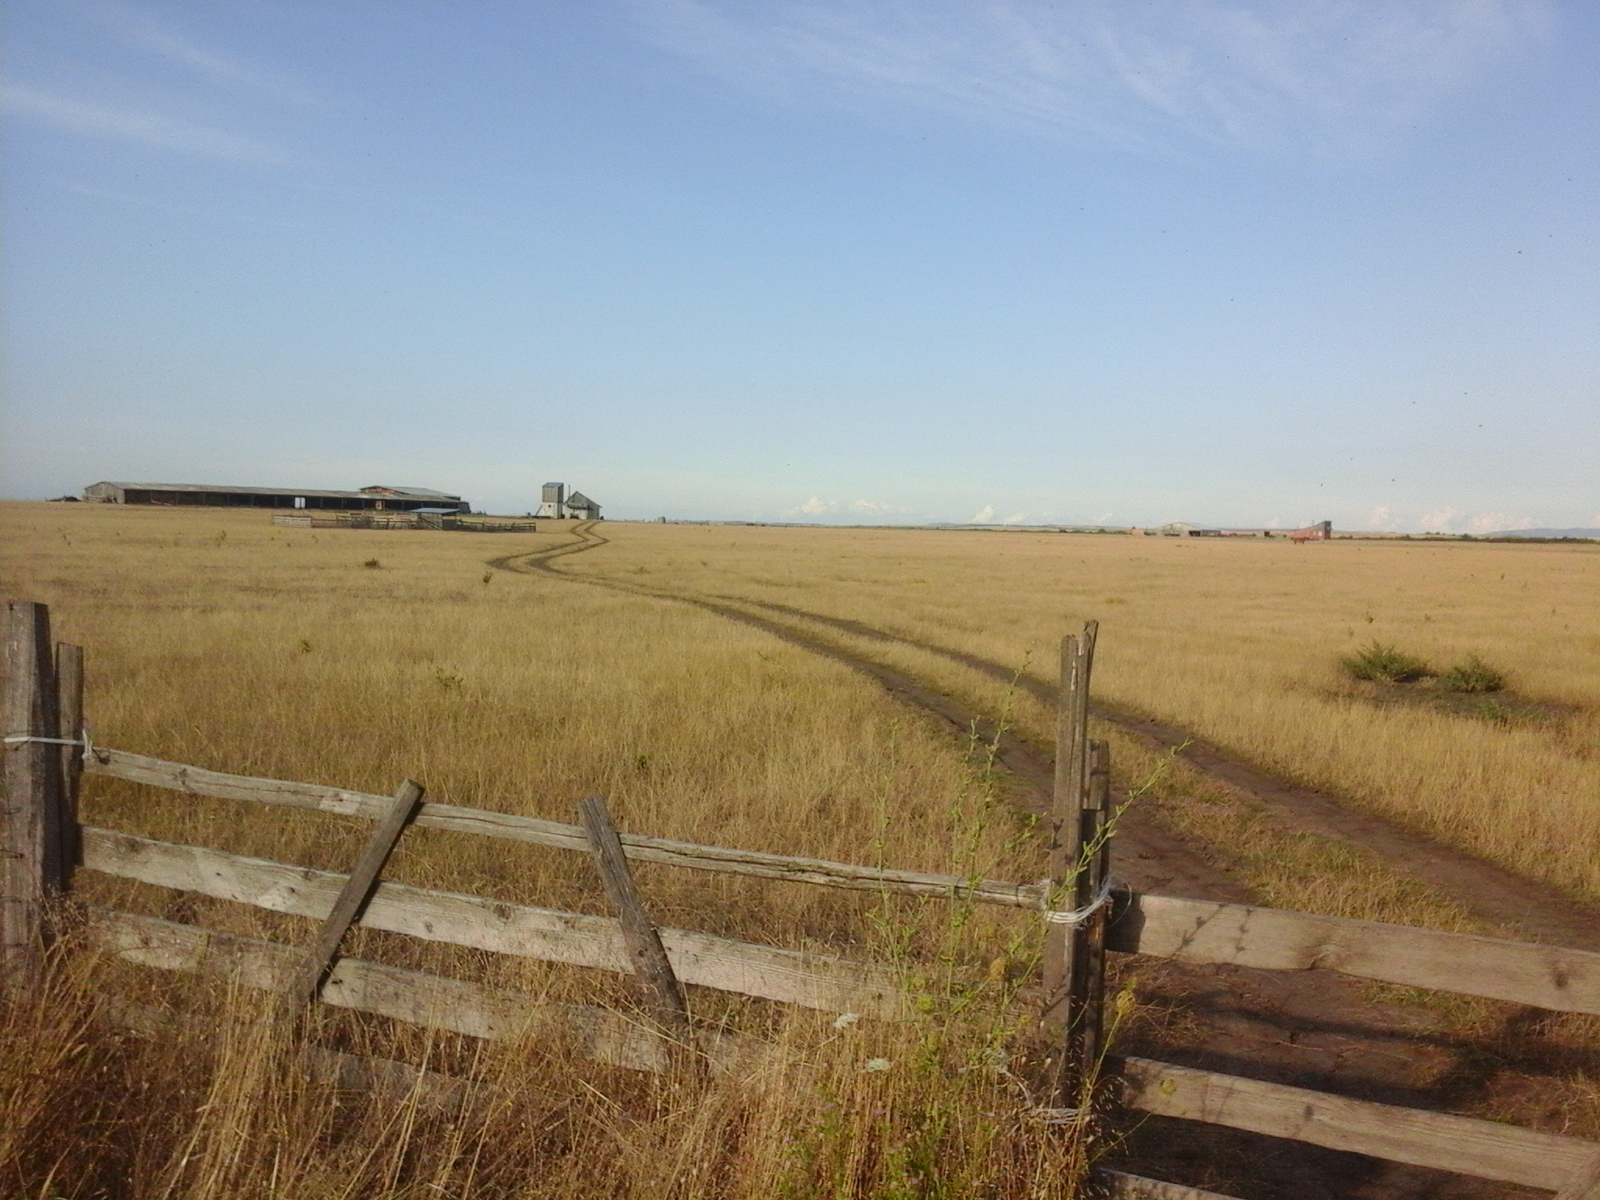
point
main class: Grassland
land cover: Grassland without tree/shrub cover
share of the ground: > 75 %
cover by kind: herbaceous plants 100 %
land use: Agriculture (excluding fallow land and kitchen gardens)
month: August
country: RO
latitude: 45.2655
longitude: 21.4110
